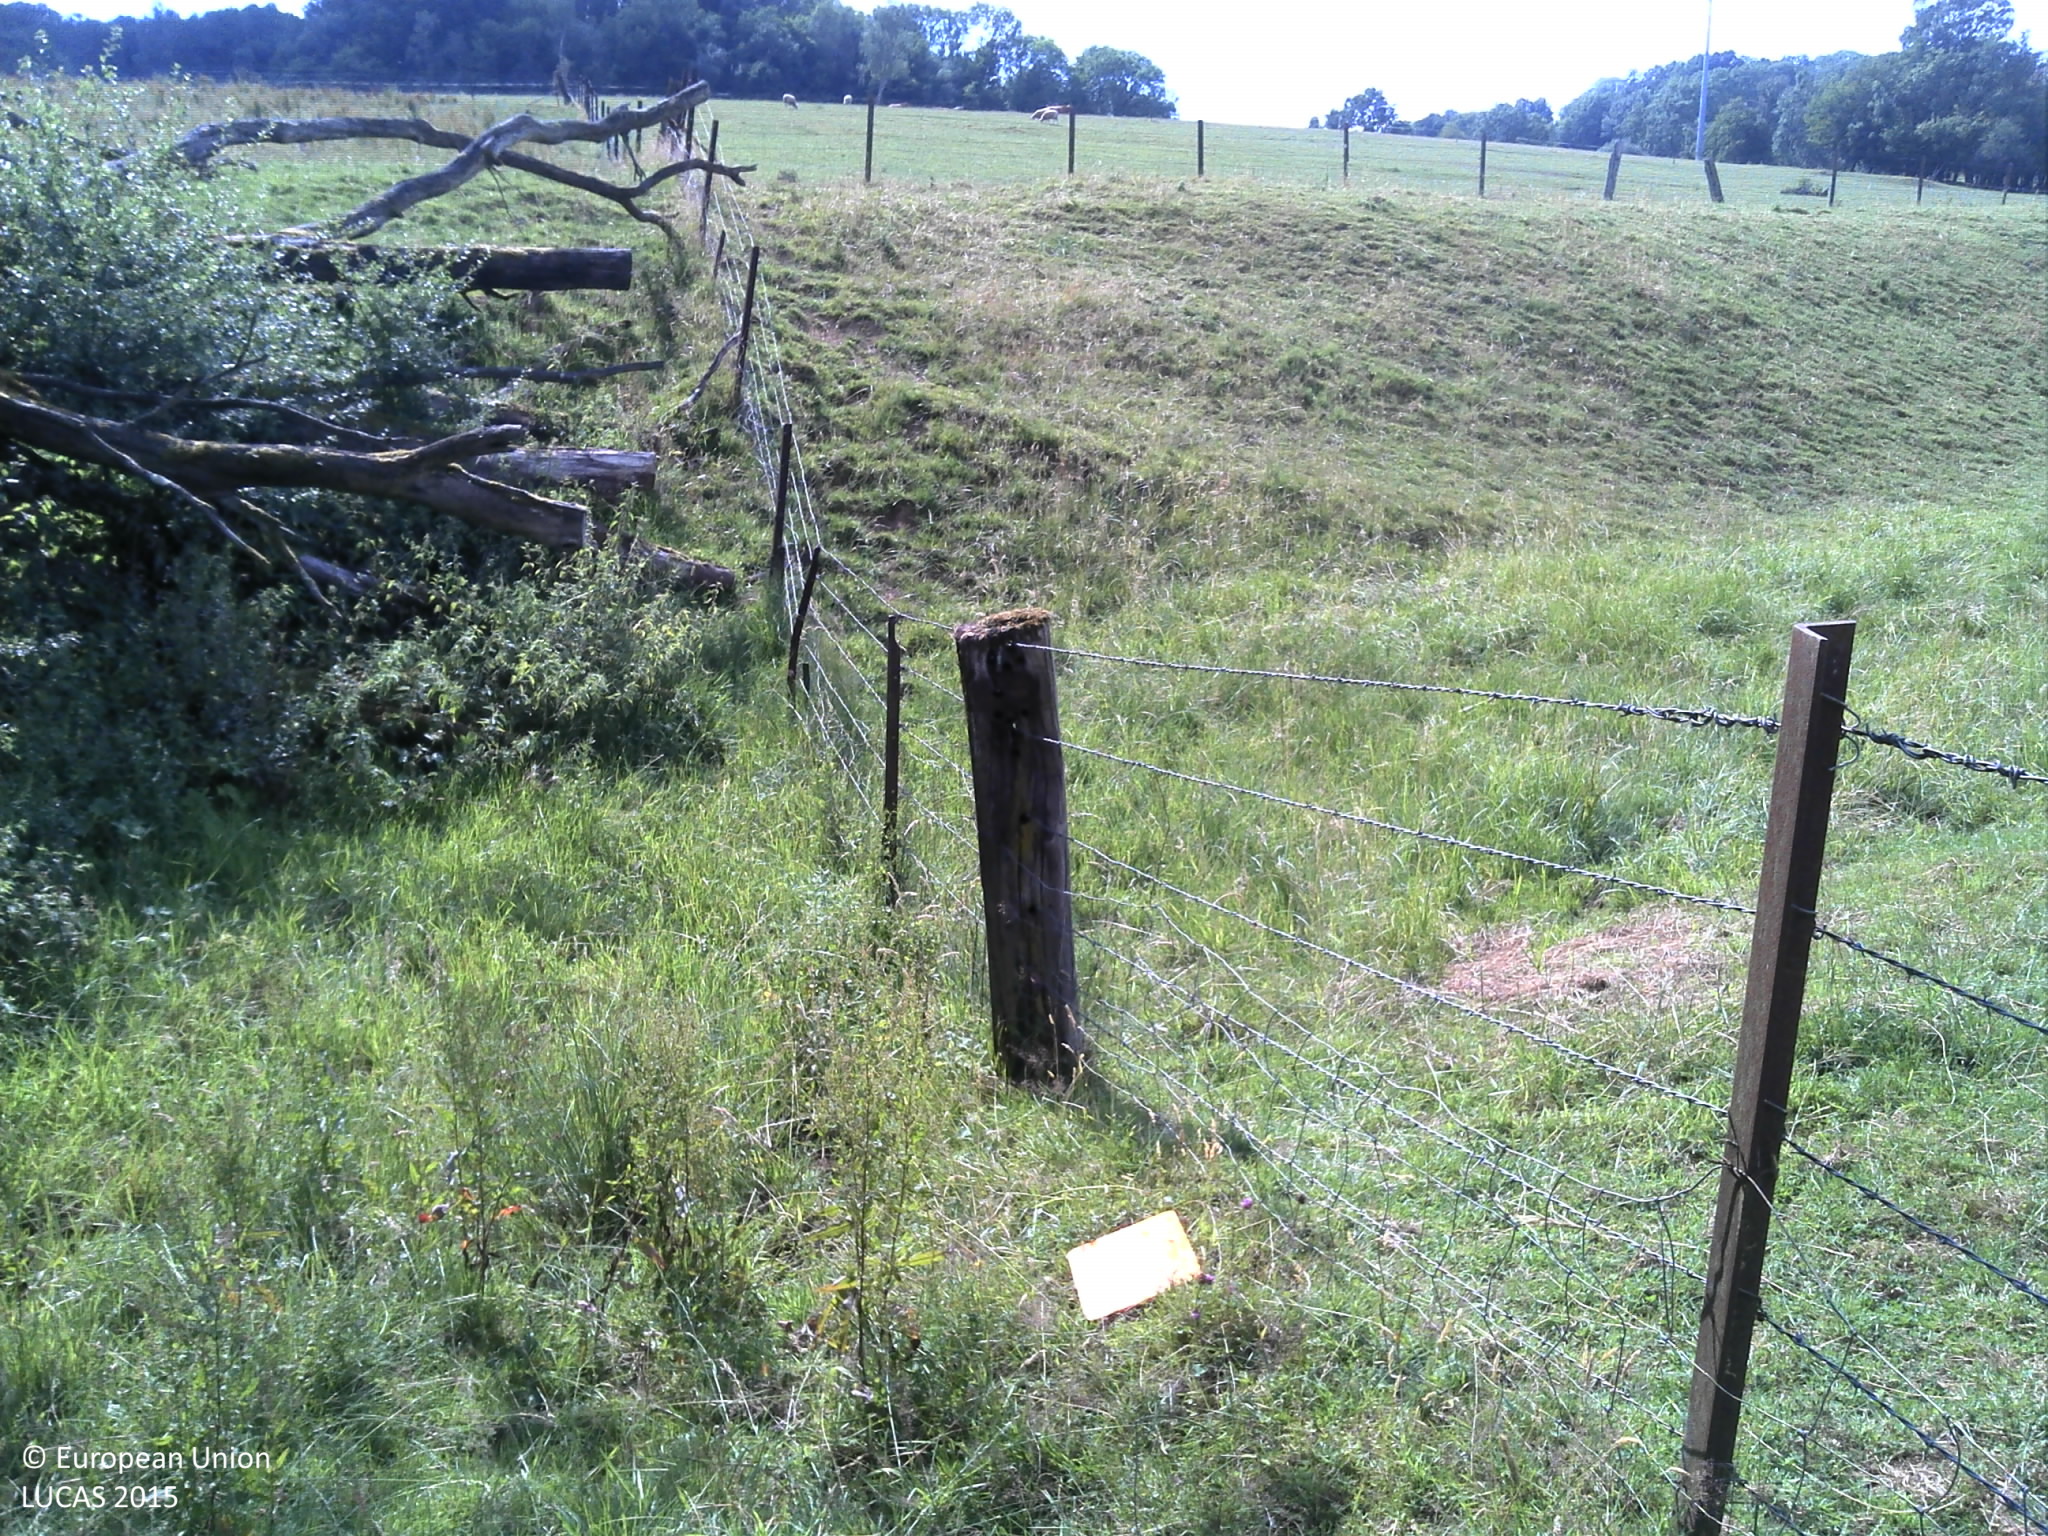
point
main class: Grassland
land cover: Grassland without tree/shrub cover
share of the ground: > 75 %
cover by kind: herbaceous plants 100 %
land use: Agriculture (excluding fallow land and kitchen gardens)
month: July
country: FR
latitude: 49.6588
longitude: 4.5799
